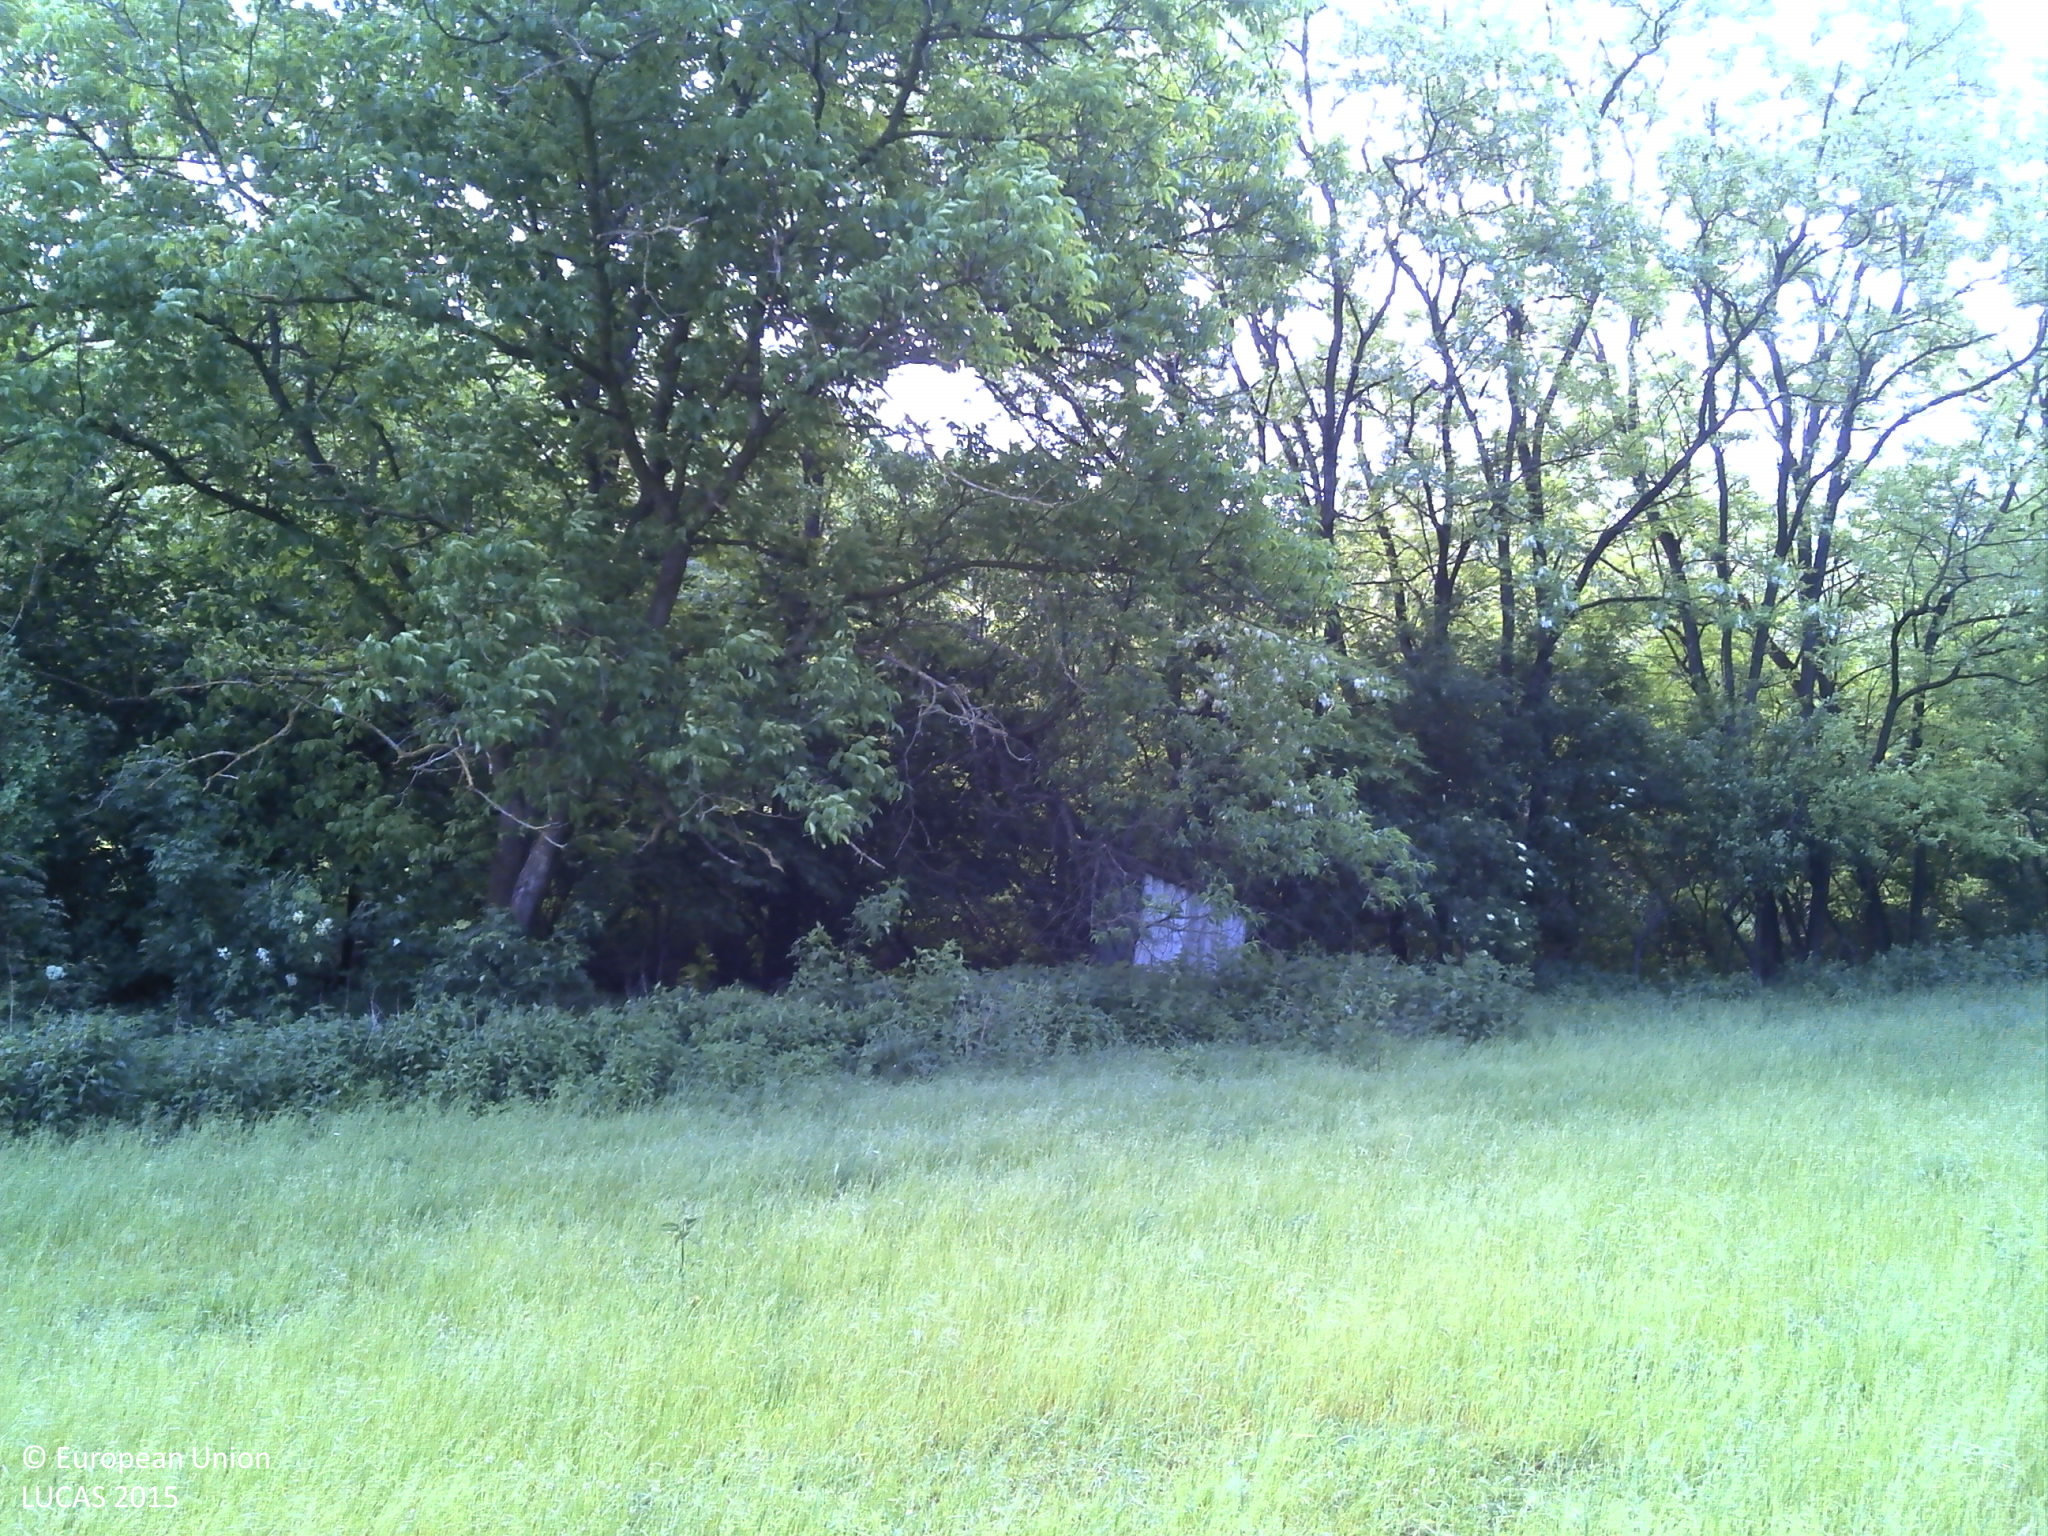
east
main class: Grassland
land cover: Grassland without tree/shrub cover
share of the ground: > 75 %
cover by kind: herbaceous plants 100 %
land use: Agriculture (excluding fallow land and kitchen gardens)
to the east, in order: Grassland without tree/shrub cover; Nuts trees; Spontaneously vegetated surfaces; Ditches and canals; Broadleaved woodland; Artificial constructions in urban areas; Permanent crops (only in case pi); Tracks; Broadleaved woodland
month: May
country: HR
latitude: 45.8154
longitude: 18.6959
